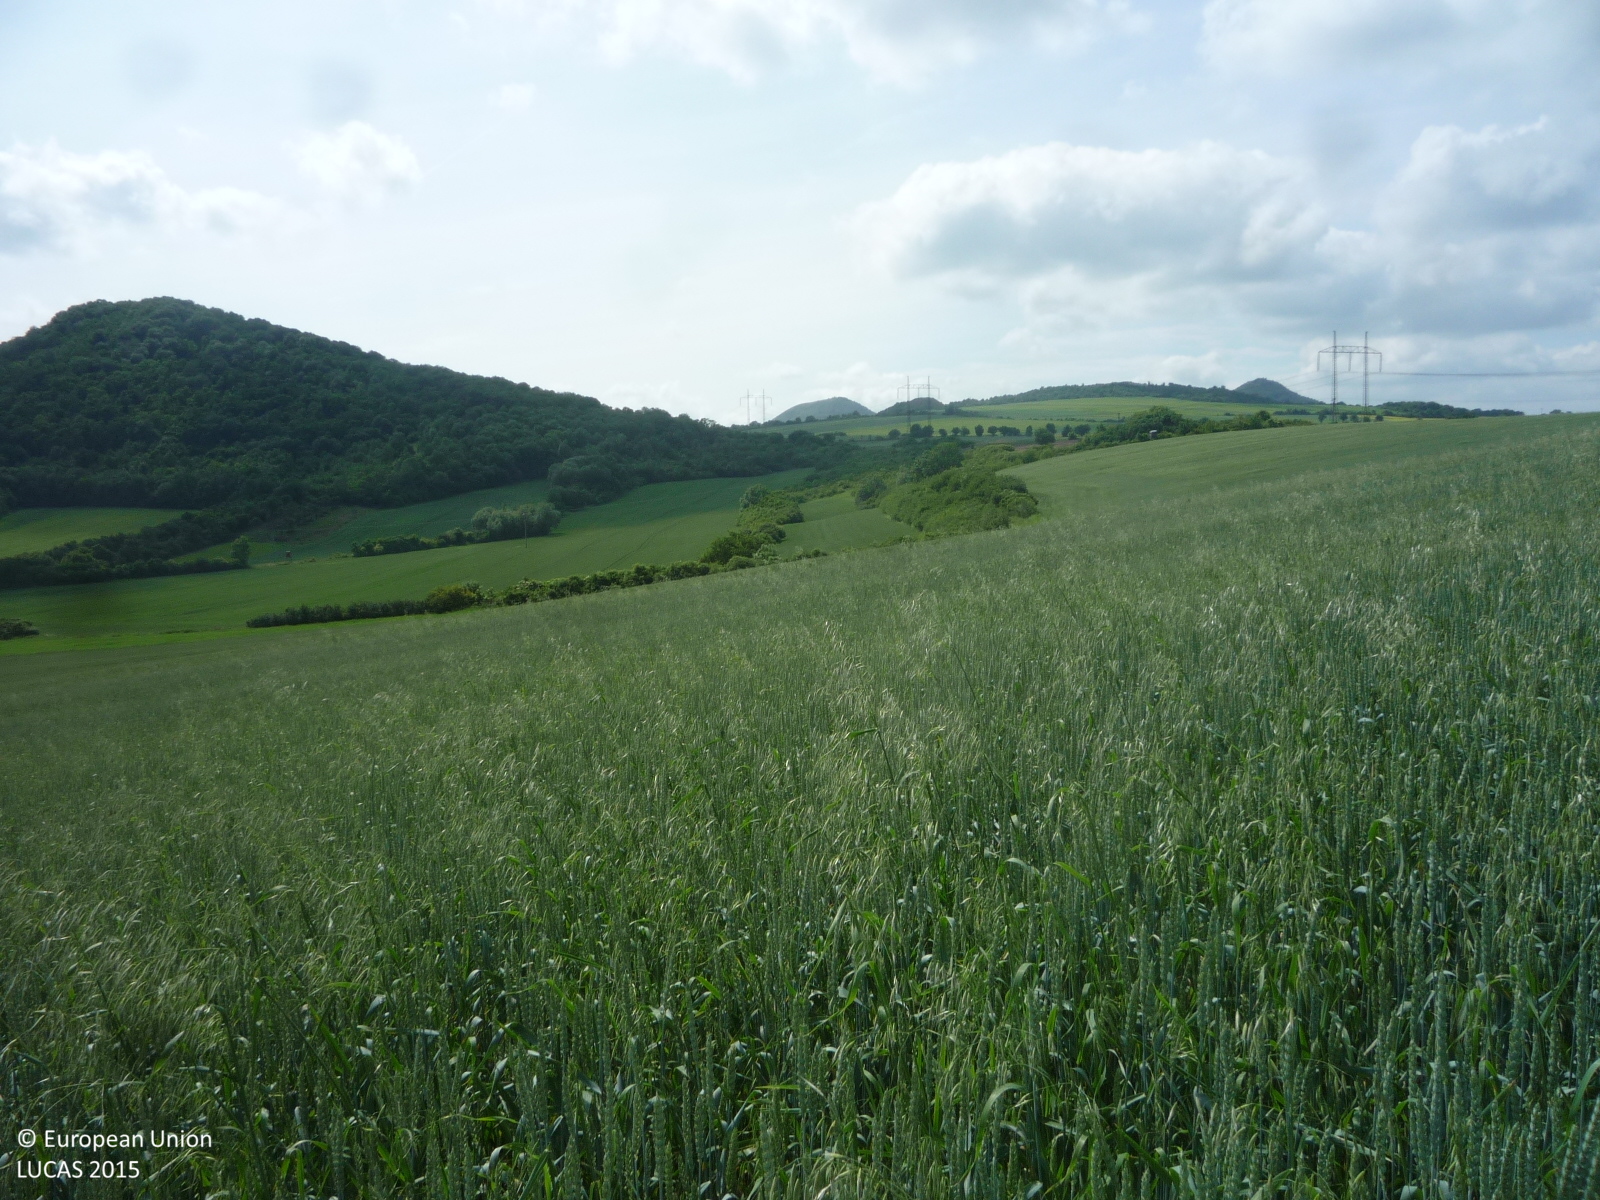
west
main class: Cropland
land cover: Common wheat
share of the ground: > 75 %
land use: Agriculture (excluding fallow land and kitchen gardens)
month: June
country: CZ
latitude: 50.4066
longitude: 13.8702
